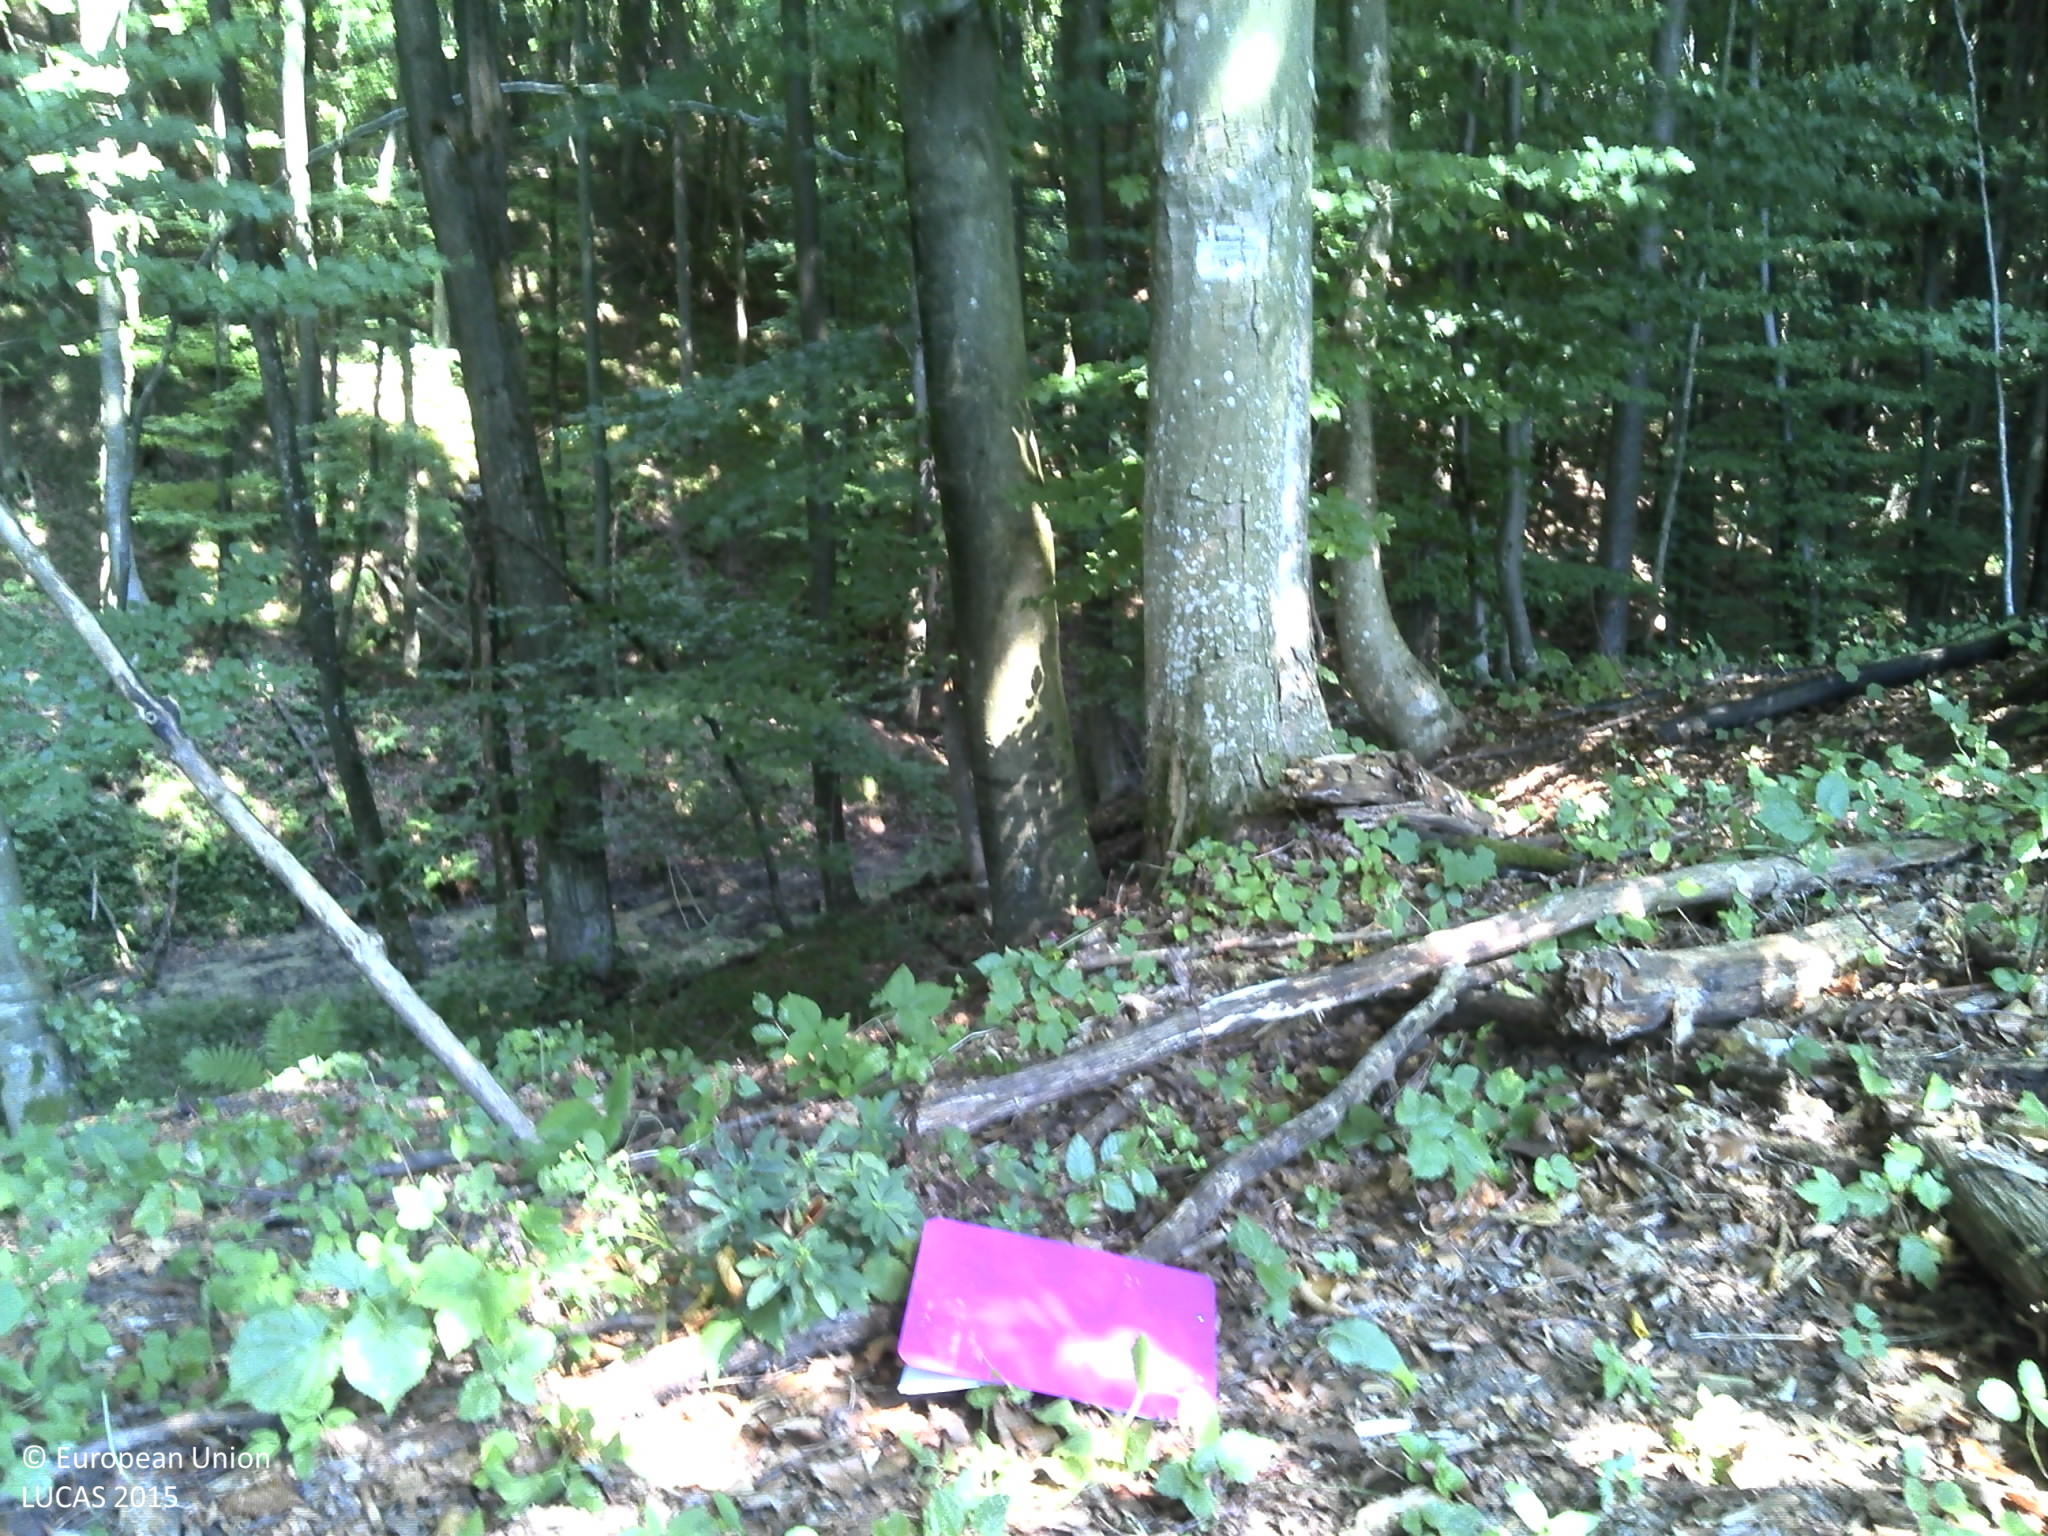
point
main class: Woodland
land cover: Broadleaved woodland
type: beech forest
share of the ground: > 75 %
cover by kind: broadleaved forest trees 100 %
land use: Forestry
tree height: > 5 m
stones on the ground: < 10 %
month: August
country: HR
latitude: 45.7639
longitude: 17.2146
